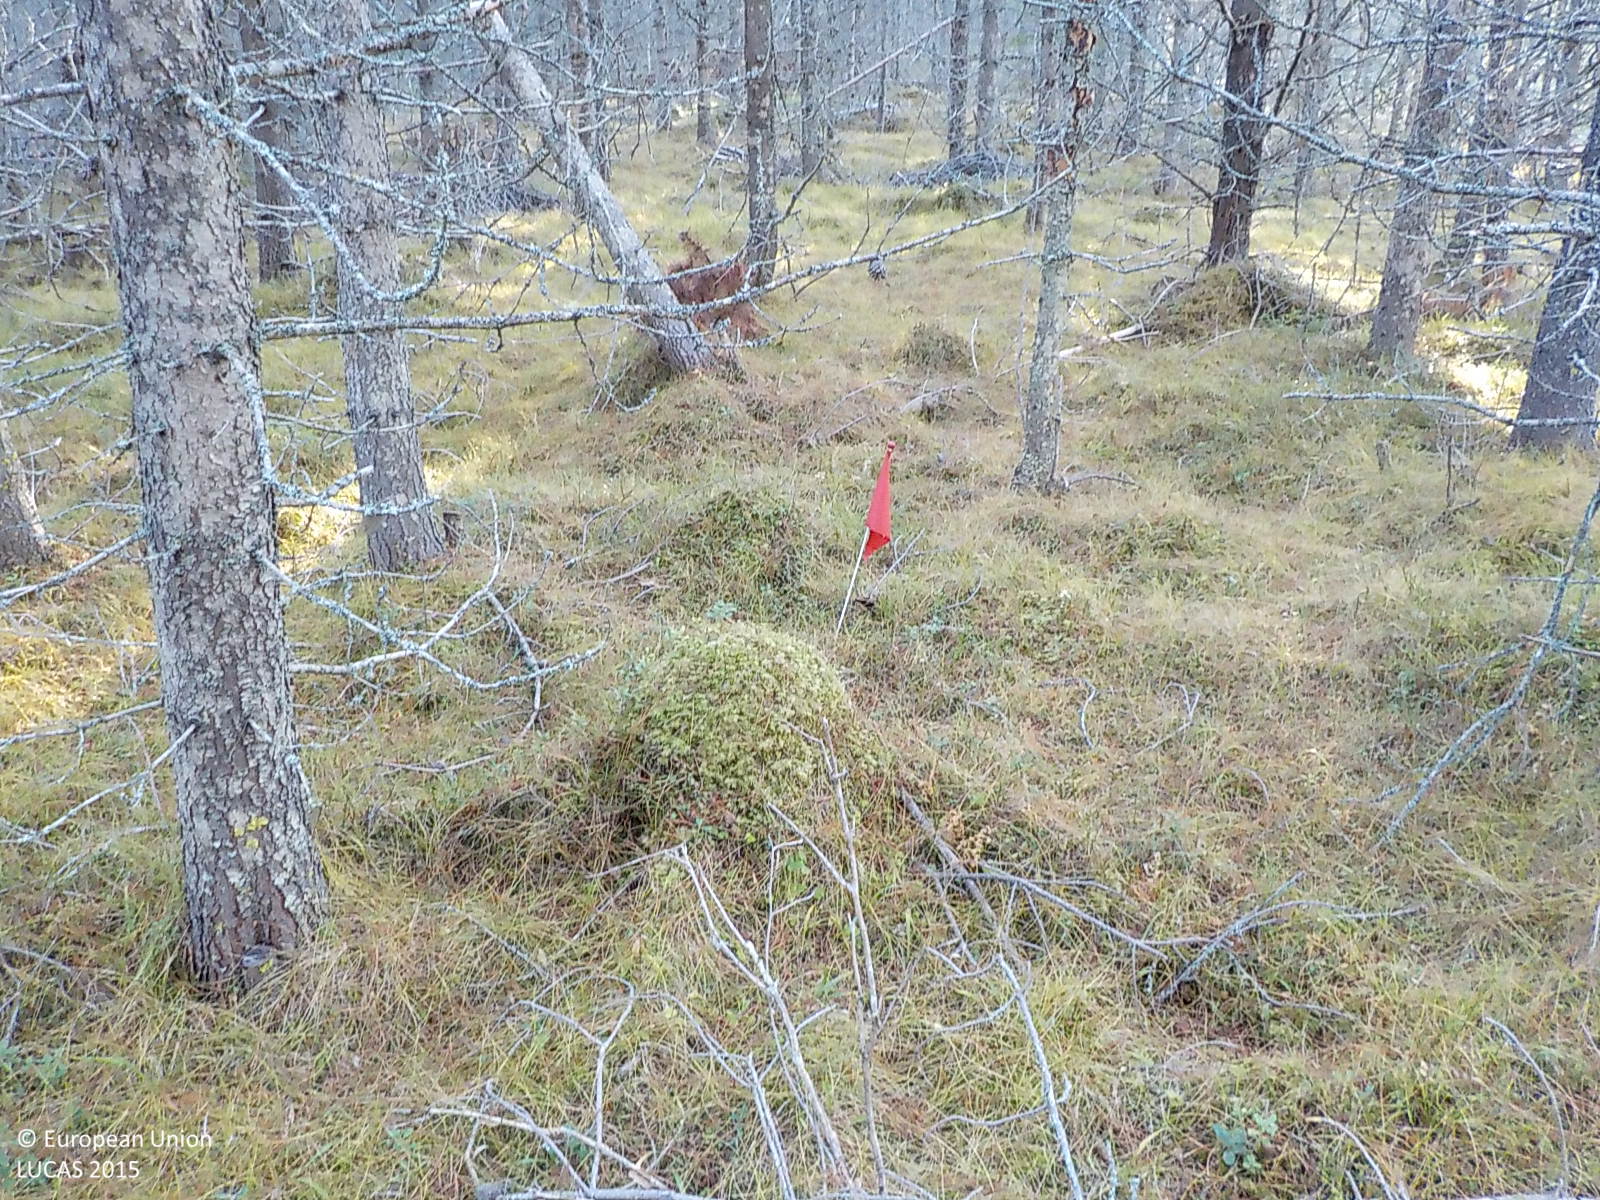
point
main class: Woodland
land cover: Other coniferous woodland
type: boreal forest
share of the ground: > 75 %
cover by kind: coniferous forest trees 75 %, shrubs 25 %
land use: Forestry
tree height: > 5 m
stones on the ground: < 10 %
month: November
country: SE
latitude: 63.2134
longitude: 16.5188
